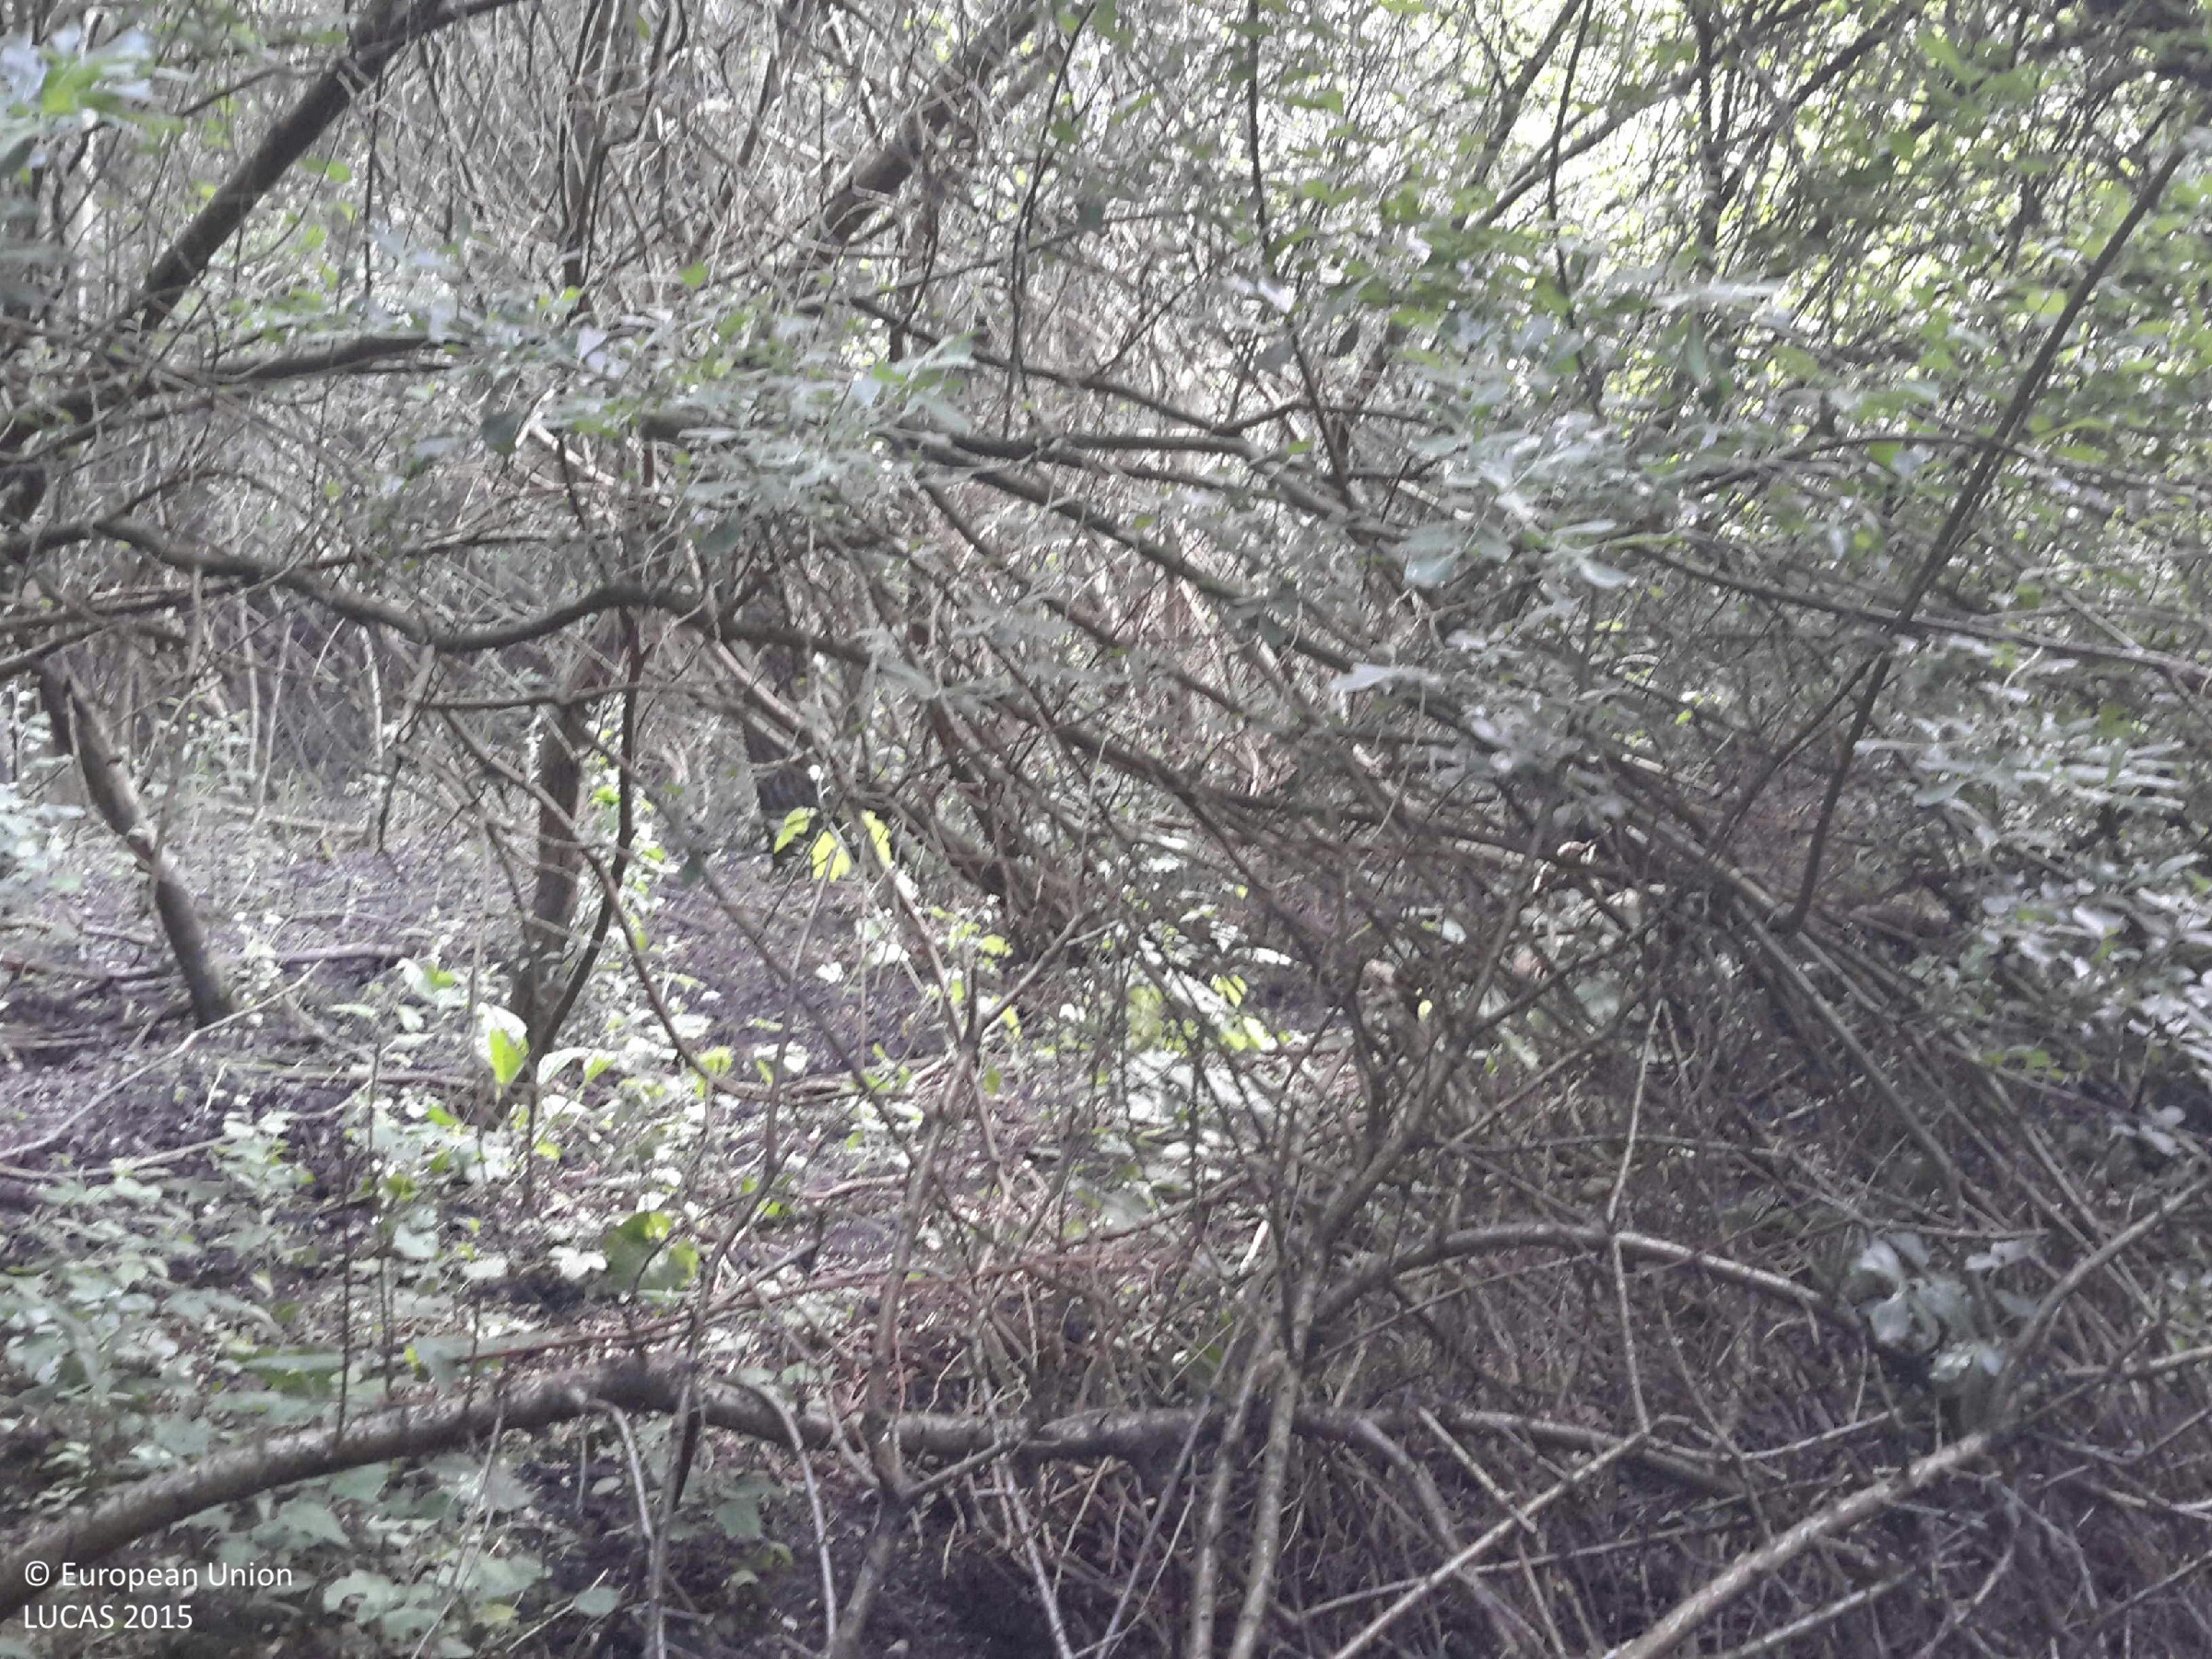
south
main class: Shrubland
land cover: Shrubland with sparse tree cover
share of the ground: > 75 %
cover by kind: shrubs 90 %, broadleaved forest trees 5 %, herbaceous plants 5 %
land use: Forestry
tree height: > 5 m
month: June
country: HU
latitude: 47.7176
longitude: 17.4601
